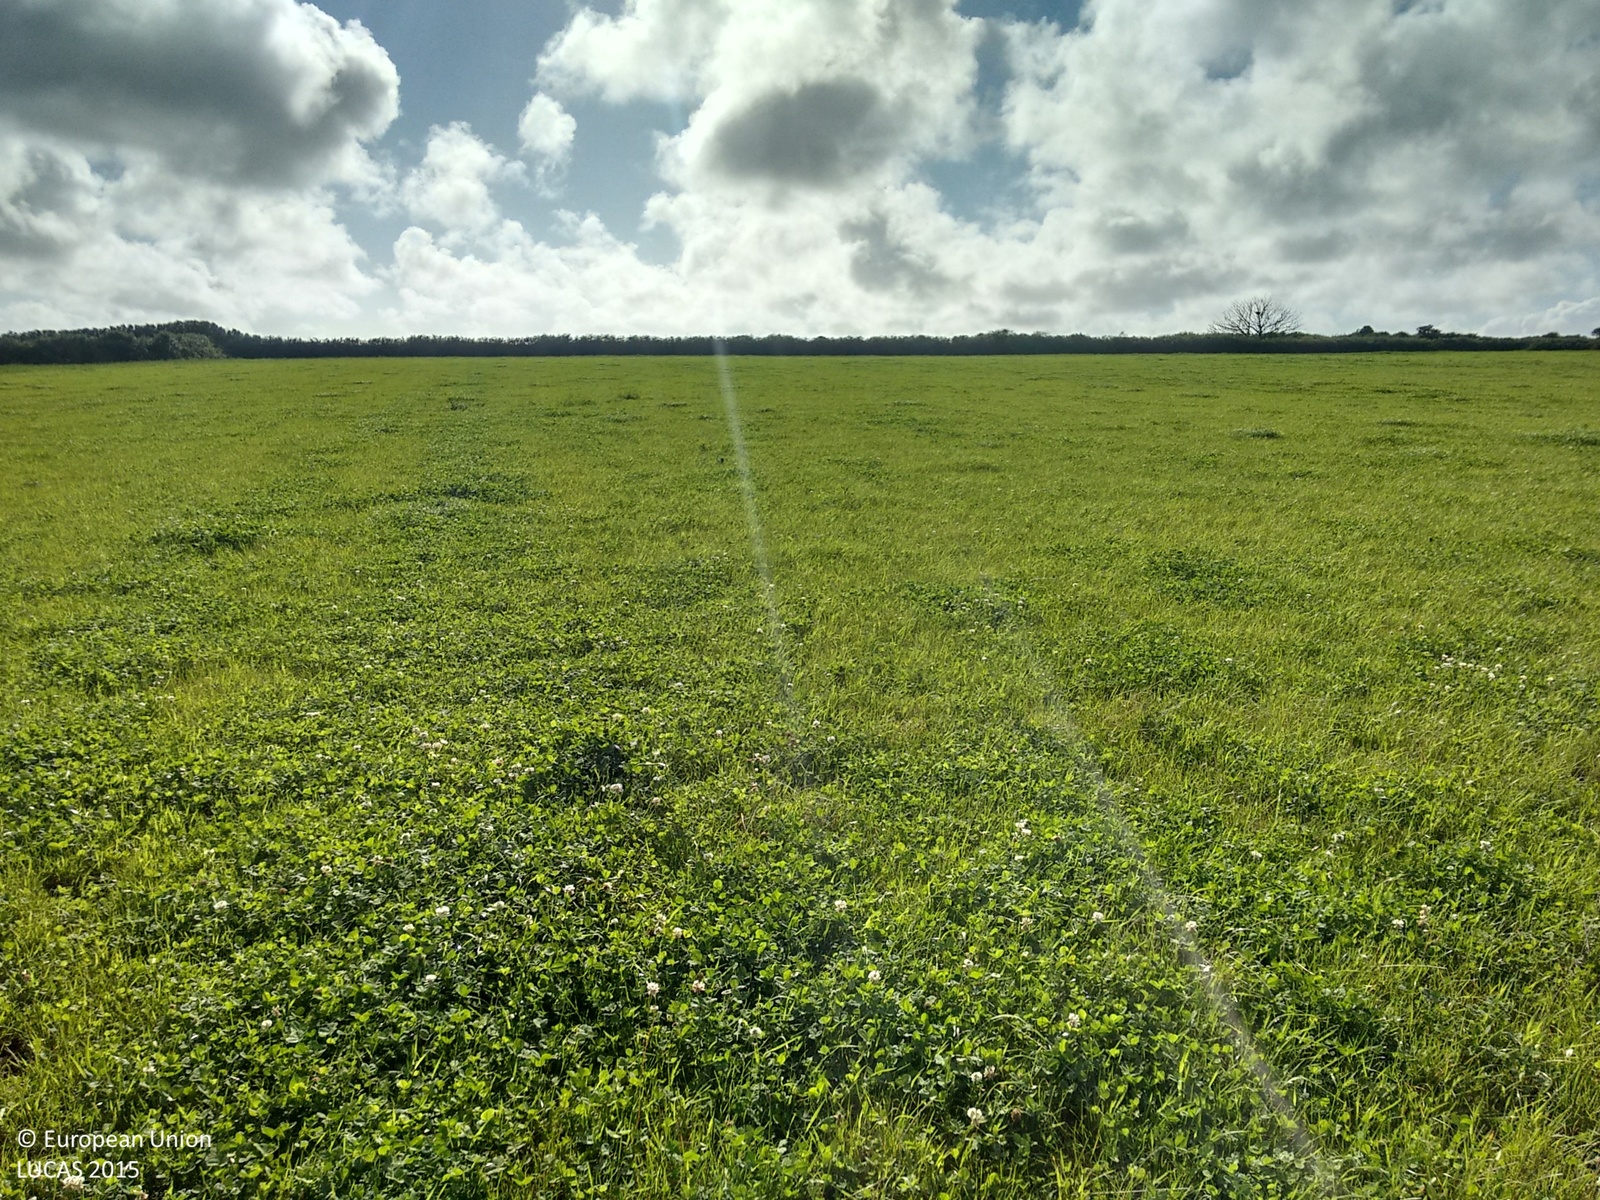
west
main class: Cropland
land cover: Clovers
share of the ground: > 75 %
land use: Agriculture (excluding fallow land and kitchen gardens)
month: August
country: GB
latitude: 50.1619
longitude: -5.4834
